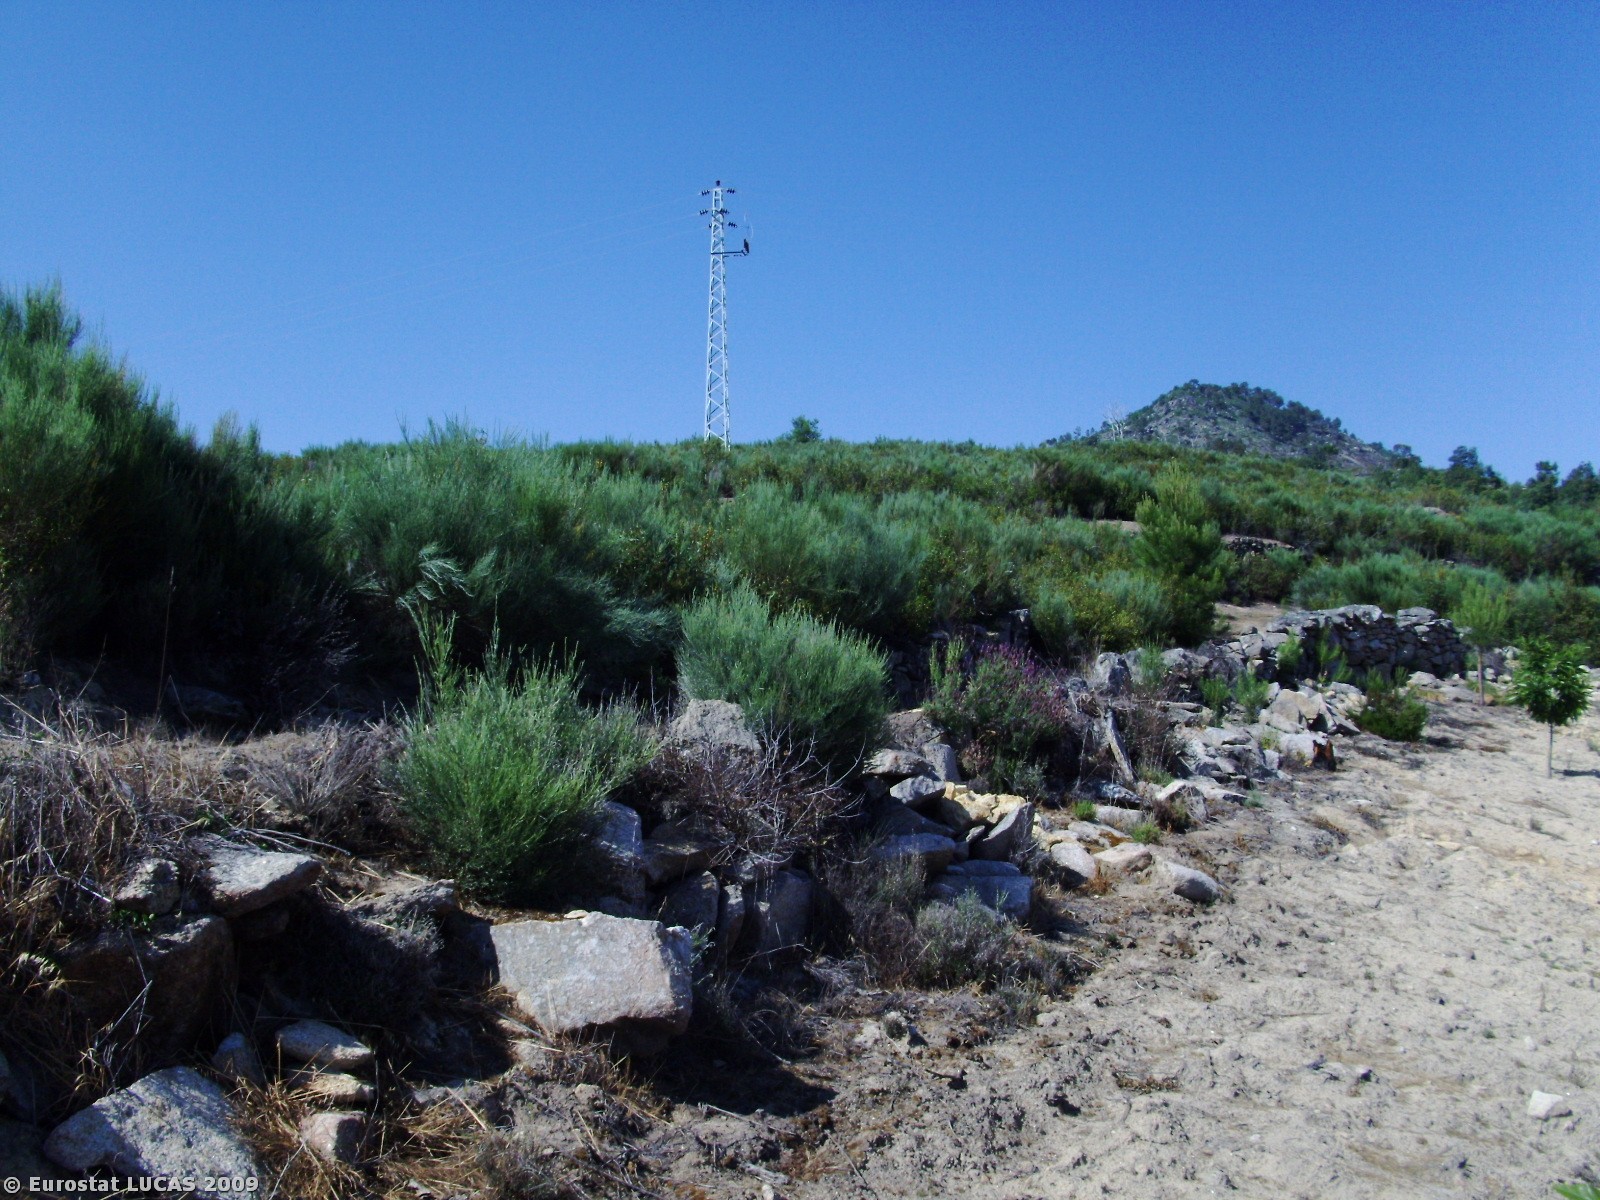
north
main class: Cropland
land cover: Nuts trees
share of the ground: 10 - 25 %
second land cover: Bare land
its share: 25 - 50 %
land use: Agriculture (excluding fallow land and kitchen gardens)
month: May
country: PT
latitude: 41.0610
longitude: -7.6033
